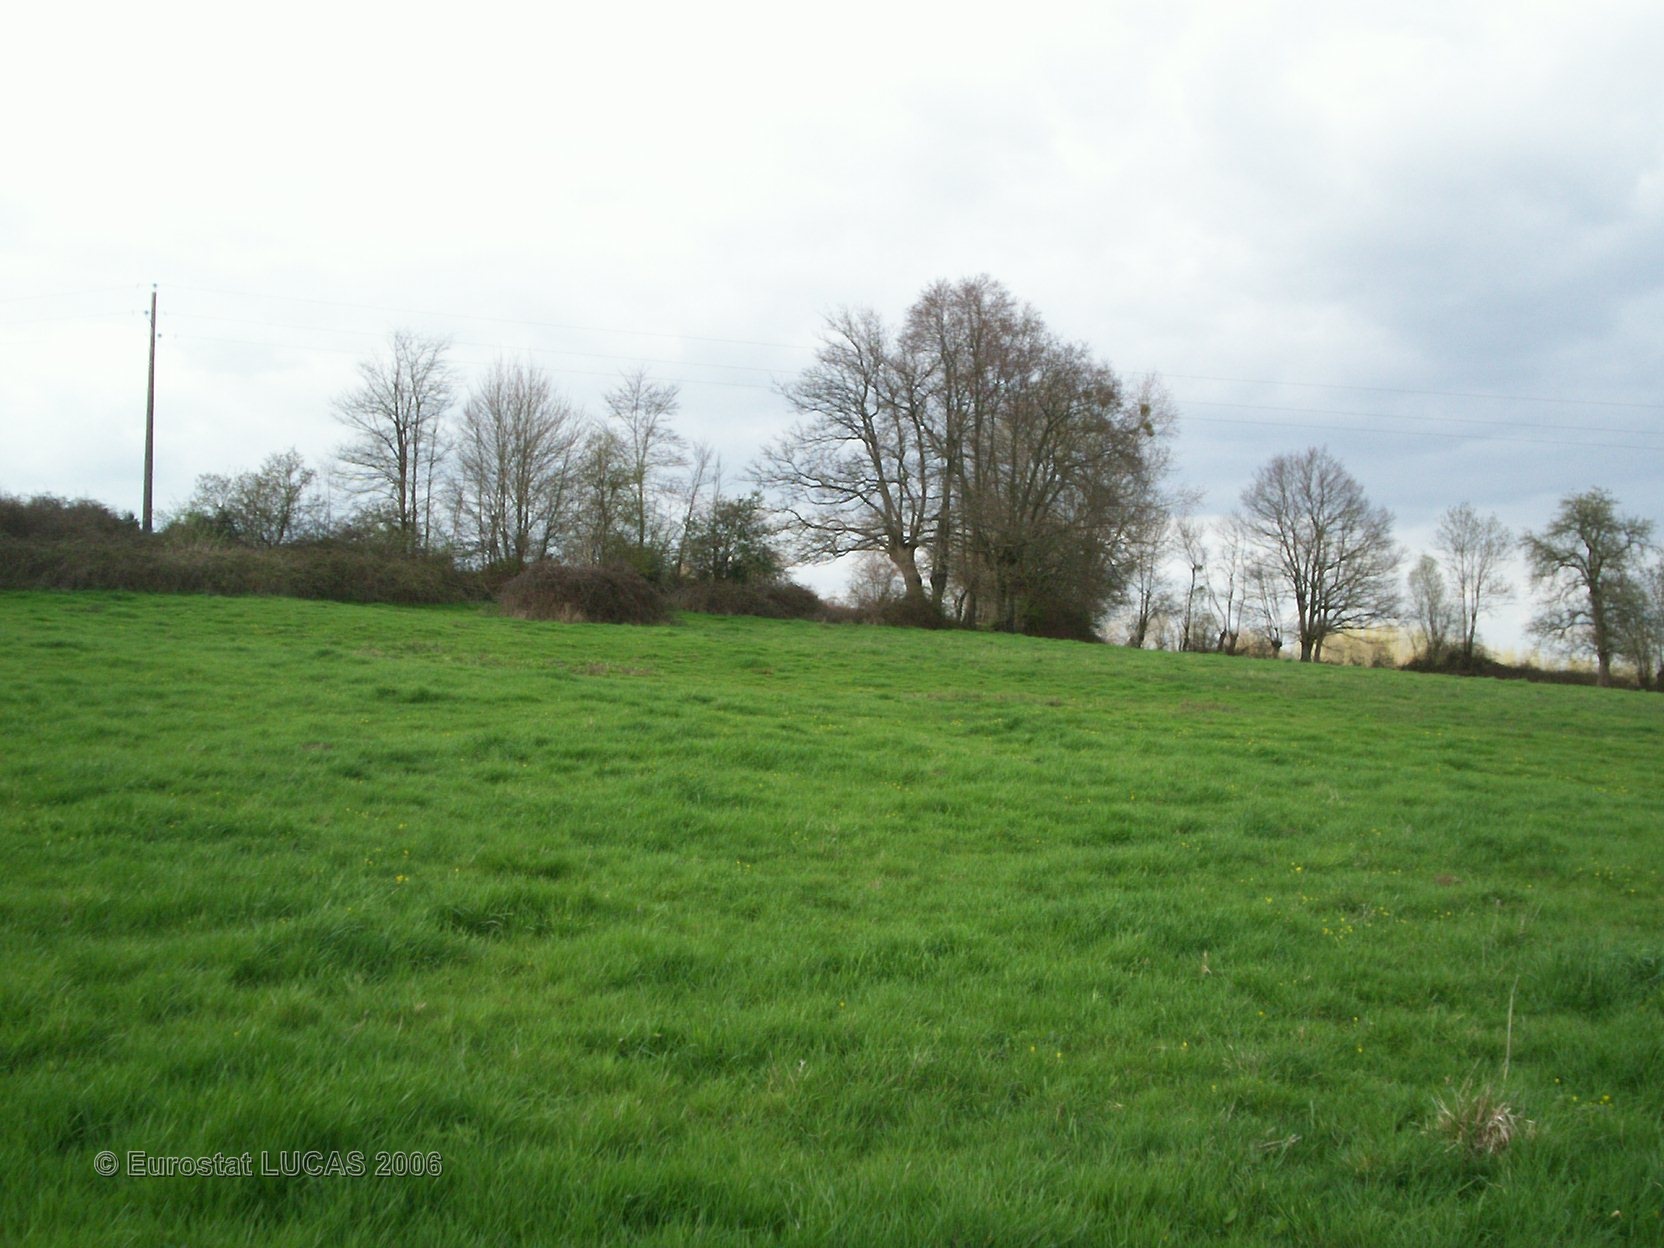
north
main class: Grassland
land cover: Grassland without tree/shrub cover
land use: Agriculture (excluding fallow land and kitchen gardens)
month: April
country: FR
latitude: 48.8989
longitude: 0.0804
